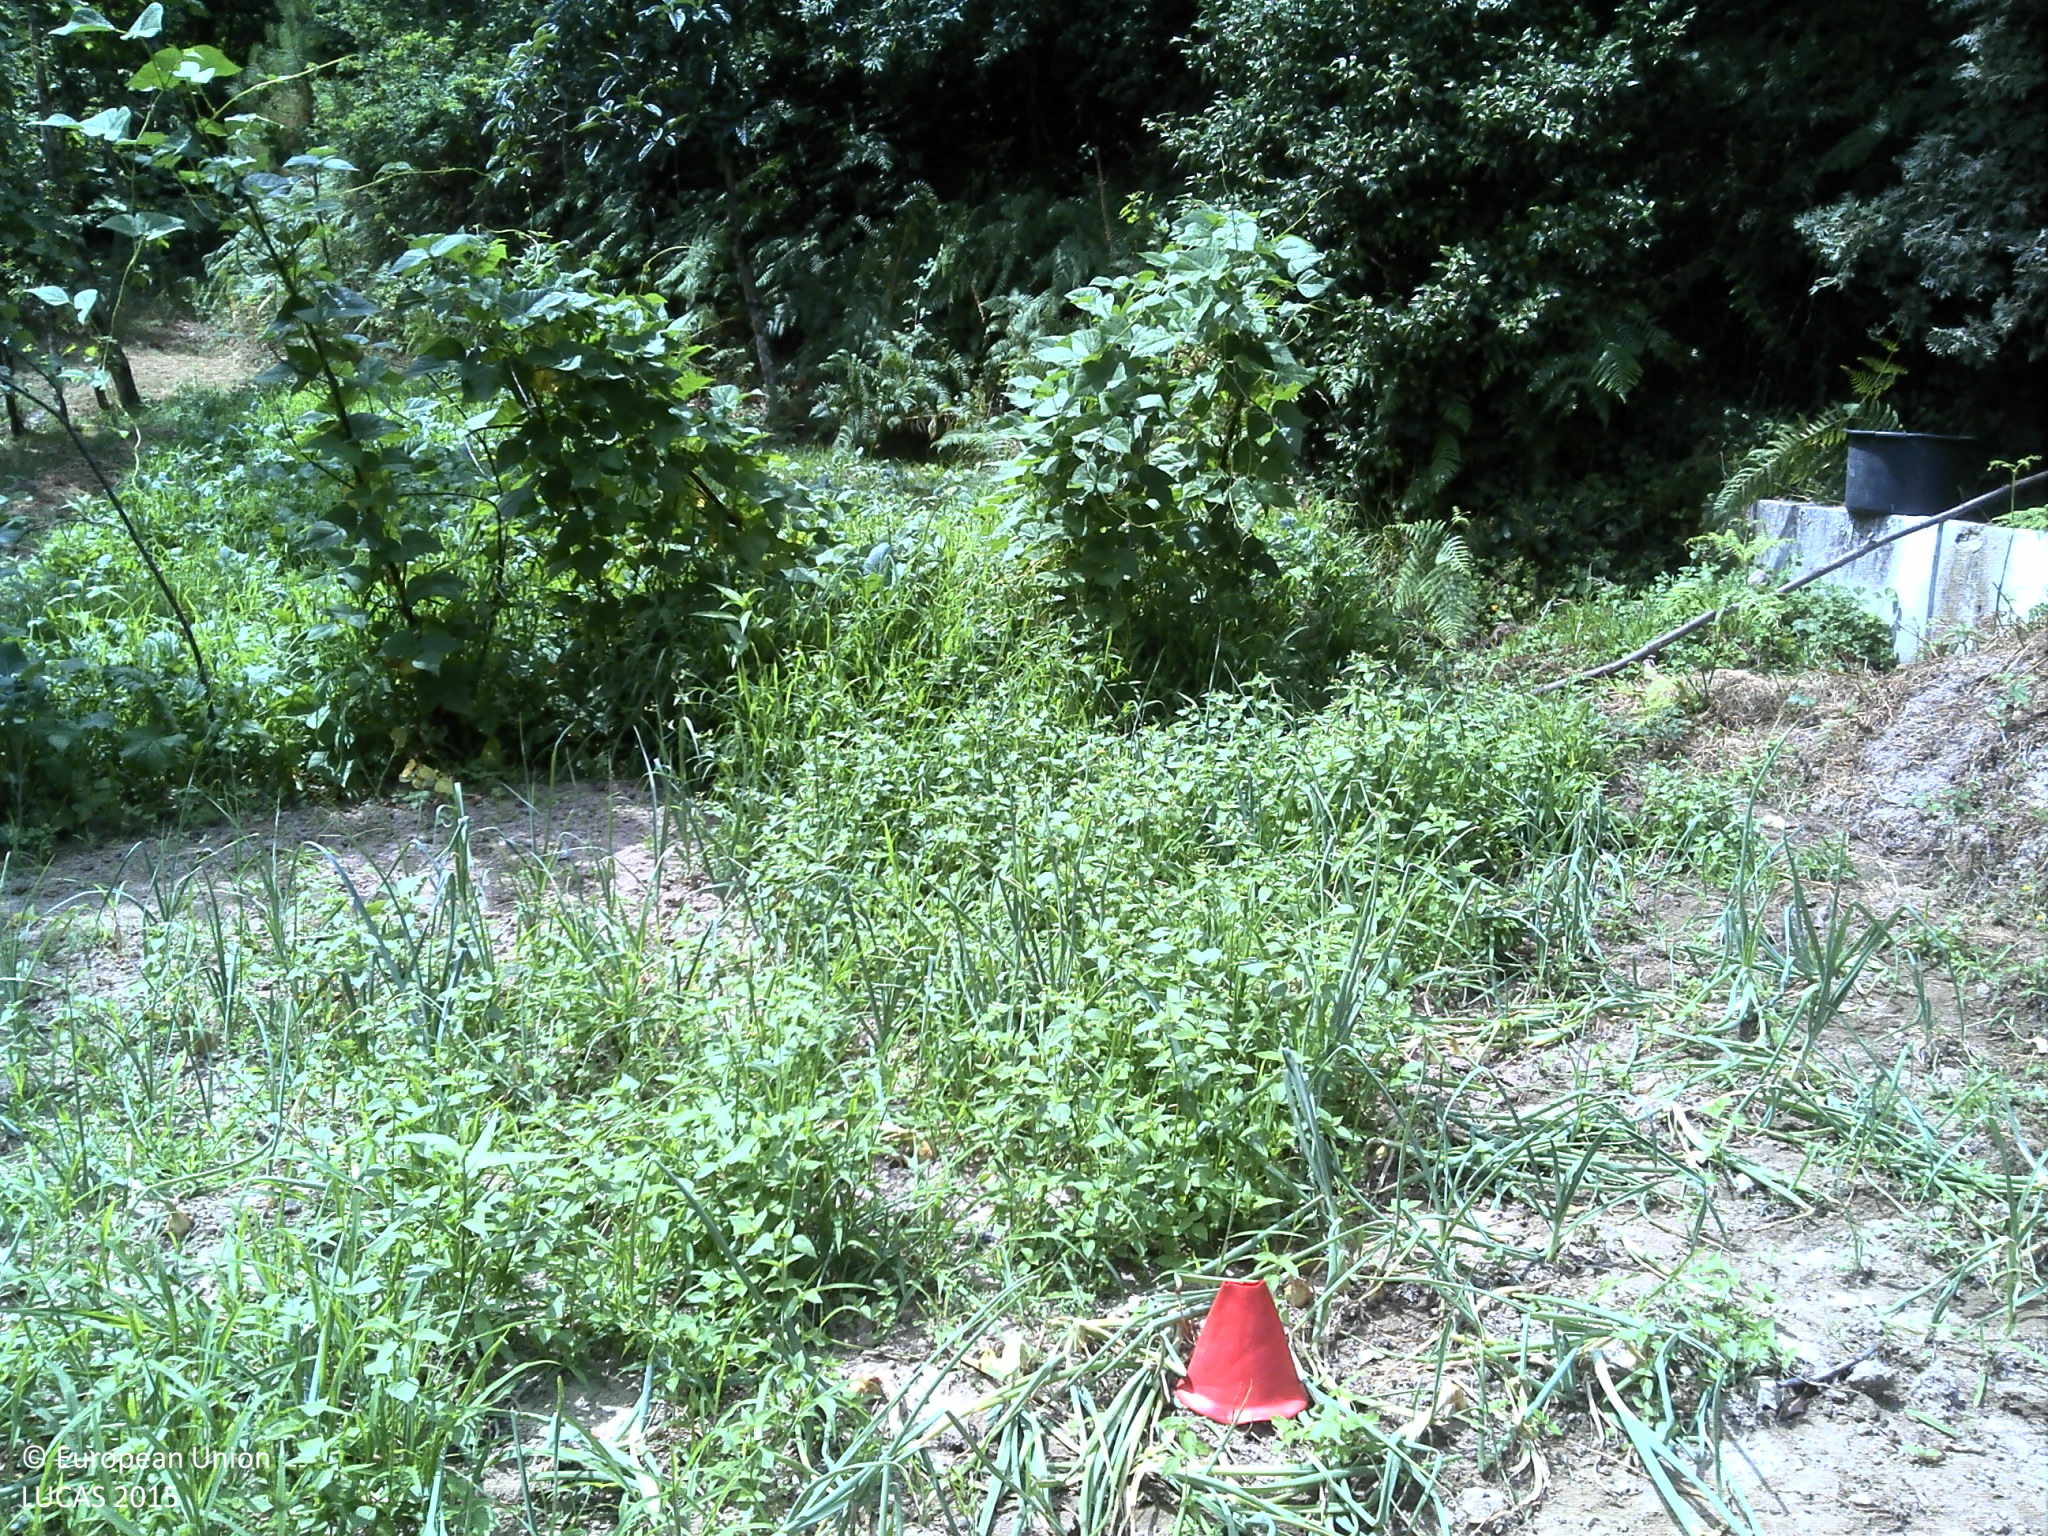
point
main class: Cropland
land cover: Other fresh vegetables
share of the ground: > 75 %
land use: Agriculture (excluding fallow land and kitchen gardens)
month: July
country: PT
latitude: 41.5006
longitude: -8.0271
